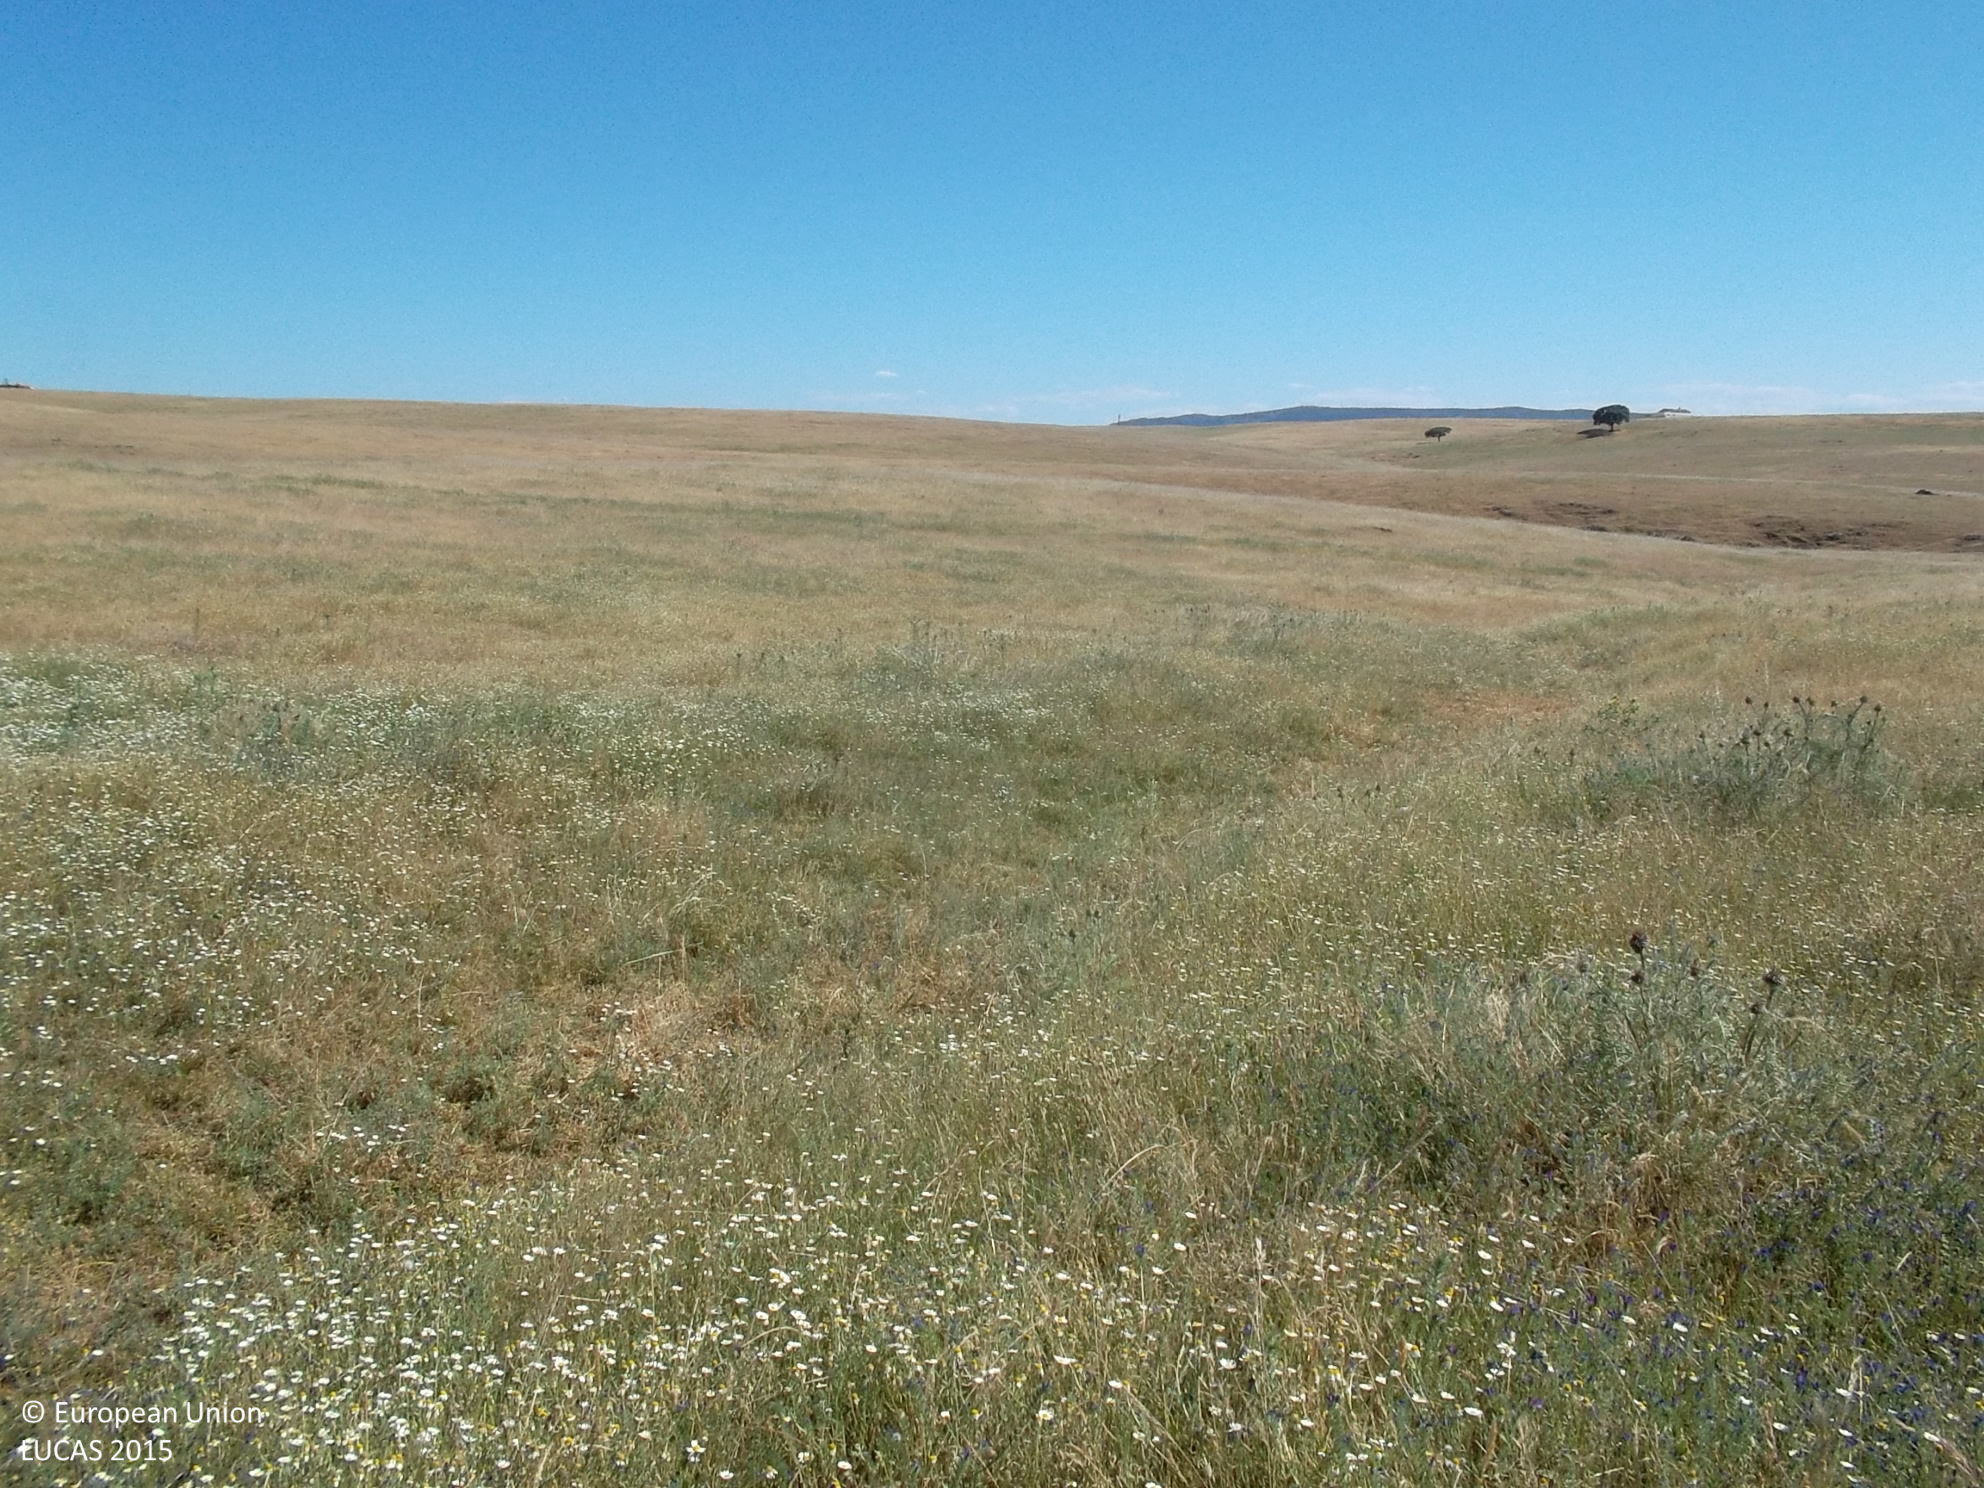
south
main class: Grassland
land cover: Grassland without tree/shrub cover
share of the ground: > 75 %
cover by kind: herbaceous plants 100 %
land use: Agriculture (excluding fallow land and kitchen gardens)
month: May
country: ES
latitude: 38.6311
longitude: -4.3917
